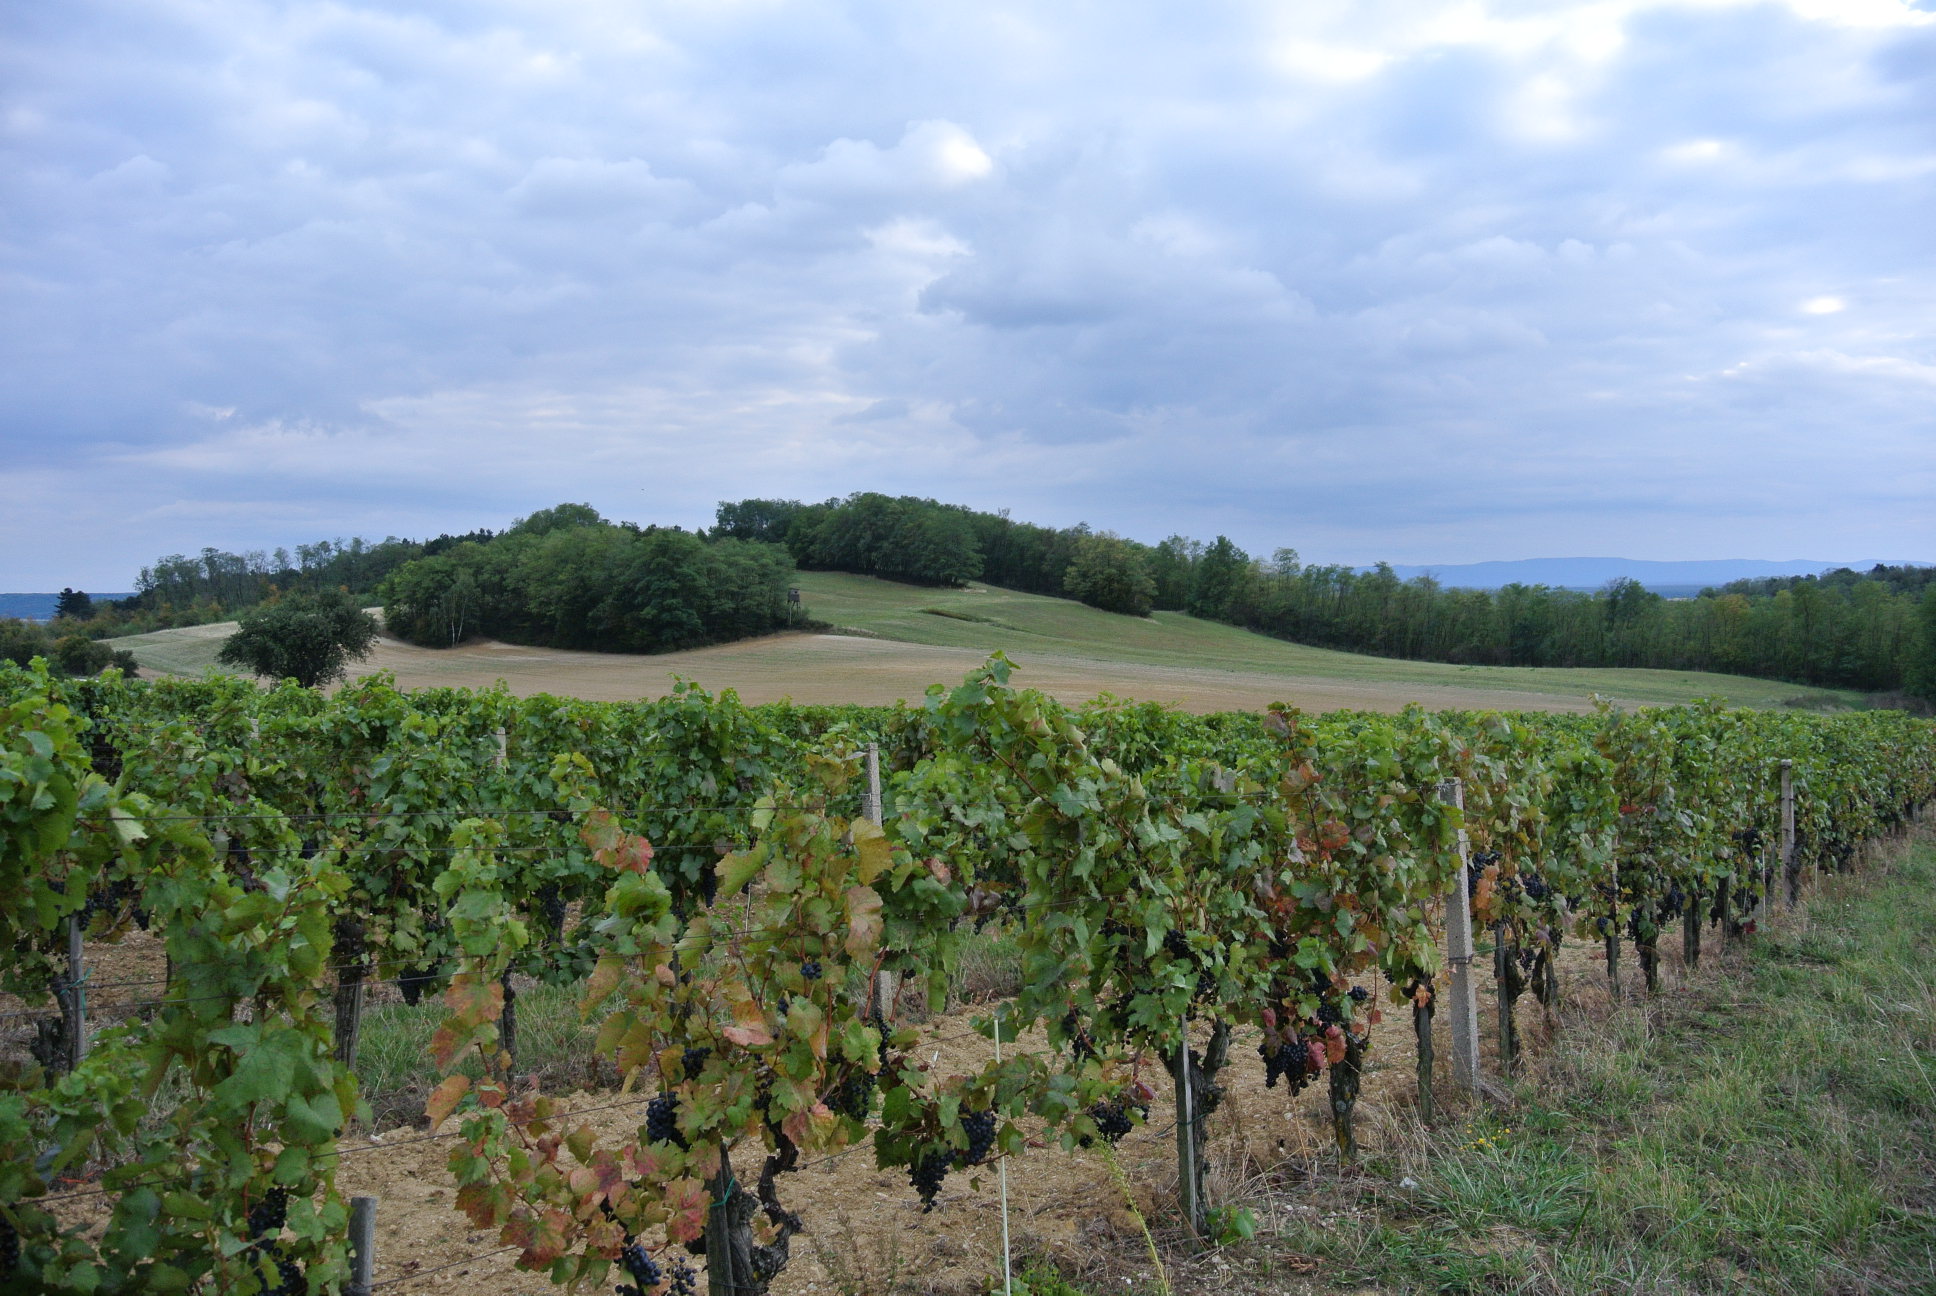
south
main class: Grassland
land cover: Grassland without tree/shrub cover
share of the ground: > 75 %
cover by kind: herbaceous plants 100 %
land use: Agriculture (excluding fallow land and kitchen gardens)
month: September
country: AT
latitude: 47.6143
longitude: 16.5365
